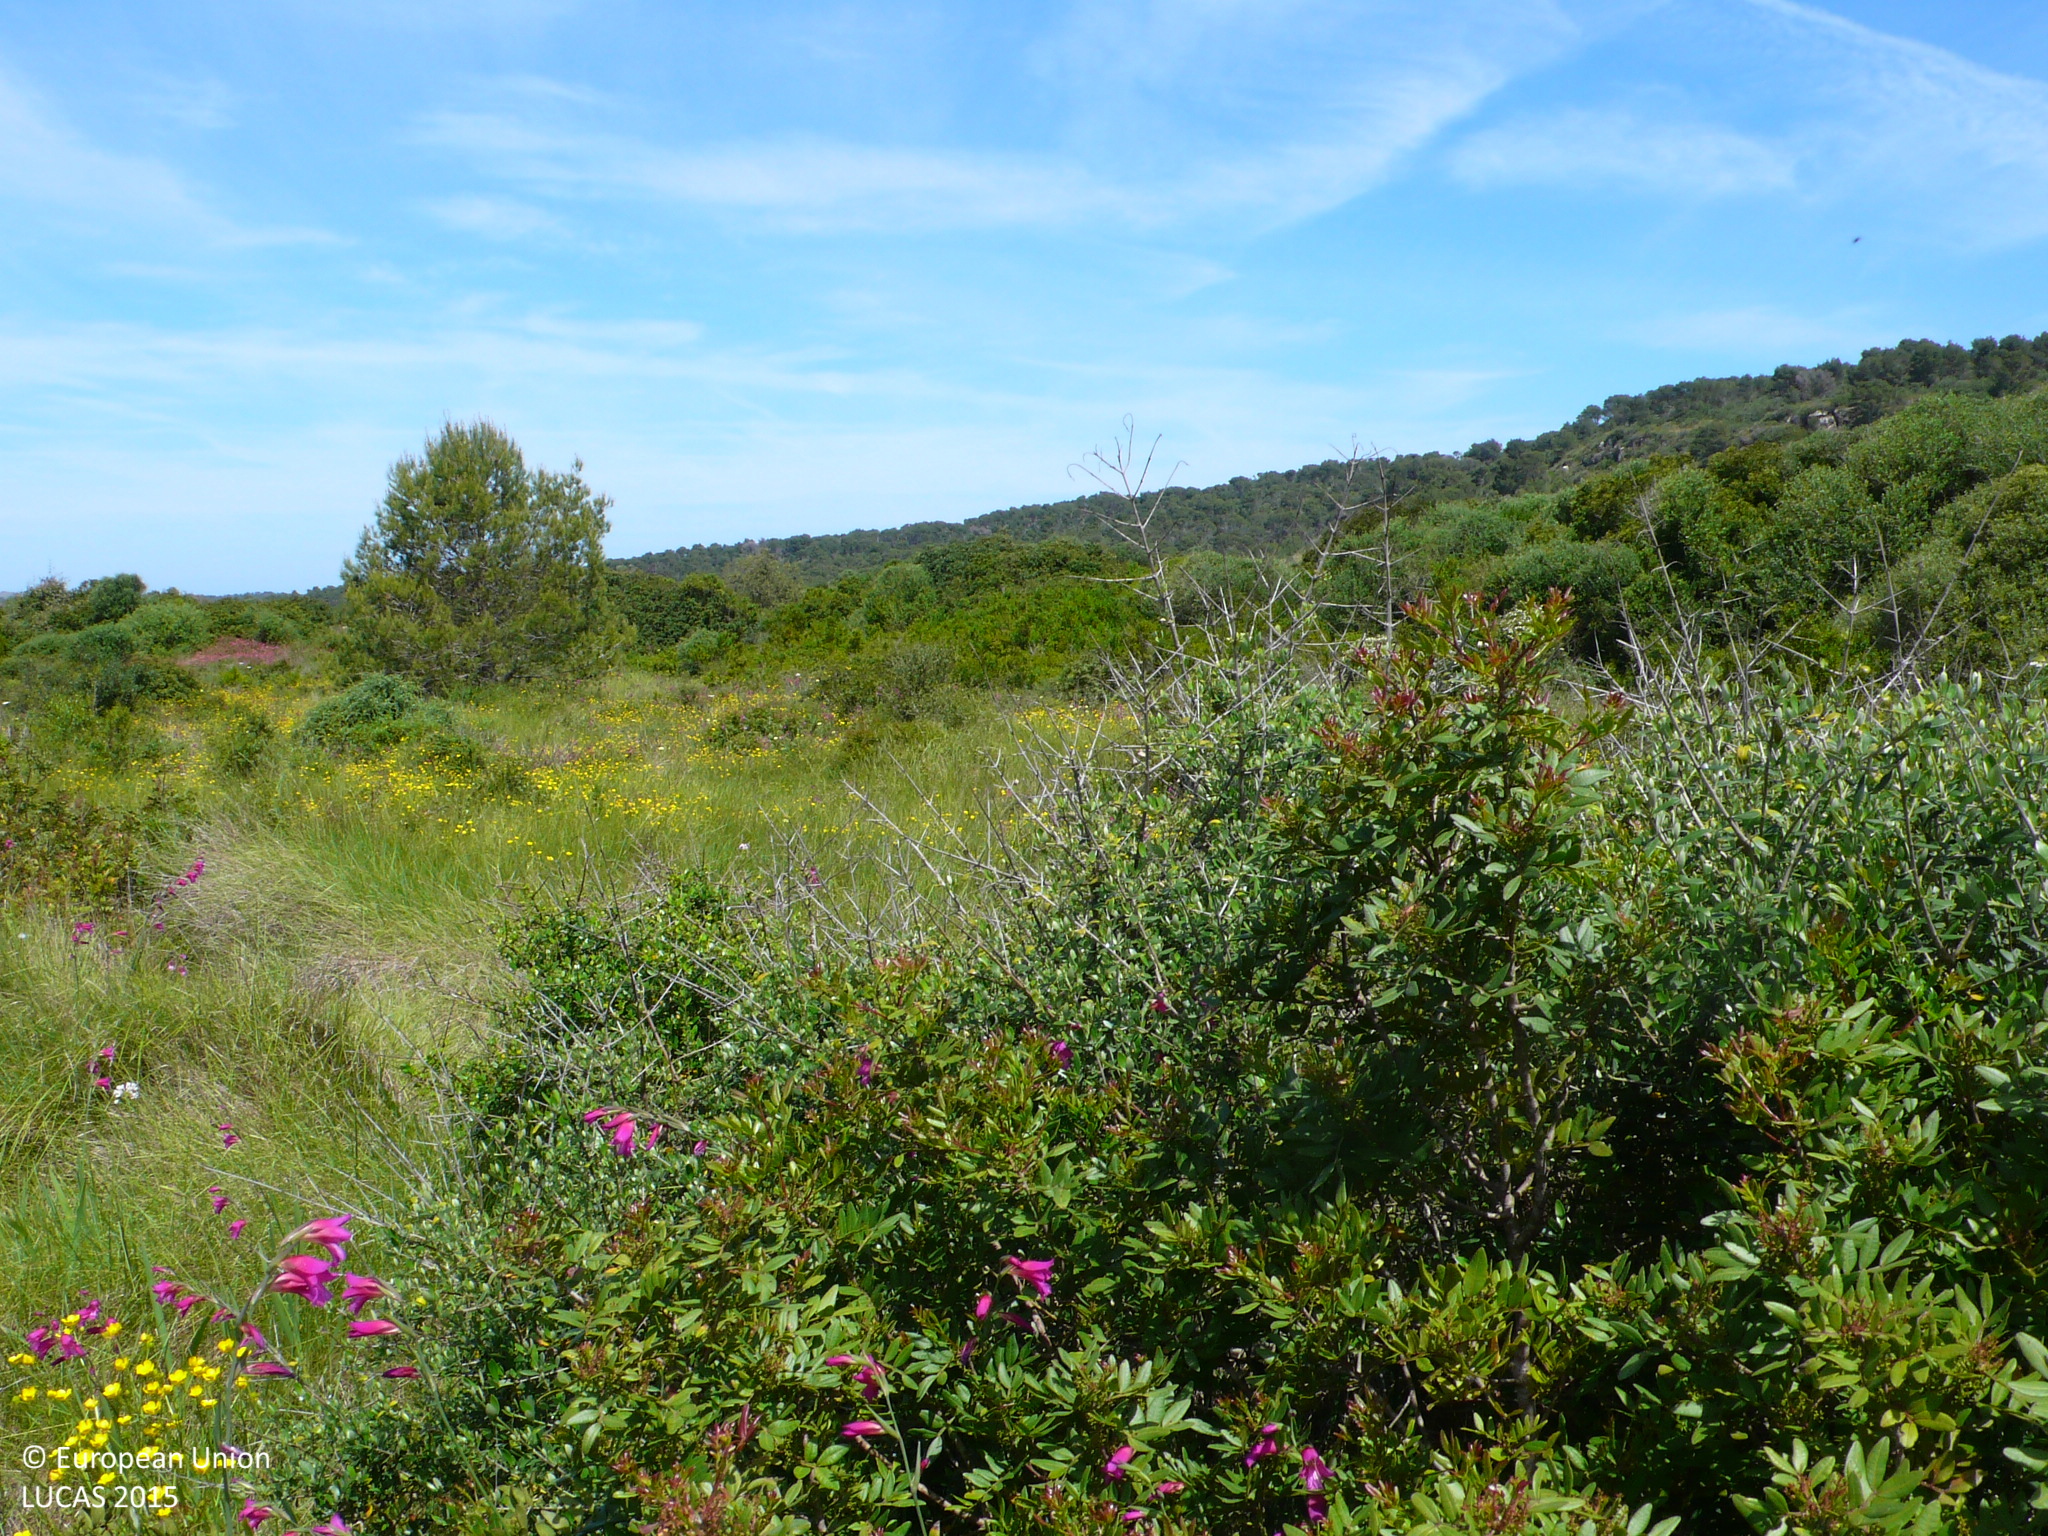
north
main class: Shrubland
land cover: Shrubland with sparse tree cover
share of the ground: 50 - 75 %
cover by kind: shrubs 55 %, herbaceous plants 40 %, broadleaved forest trees 5 %
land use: Semi-natural and natural areas not in use
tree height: < 5 m
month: May
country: ES
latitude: 40.0038
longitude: 4.1804
